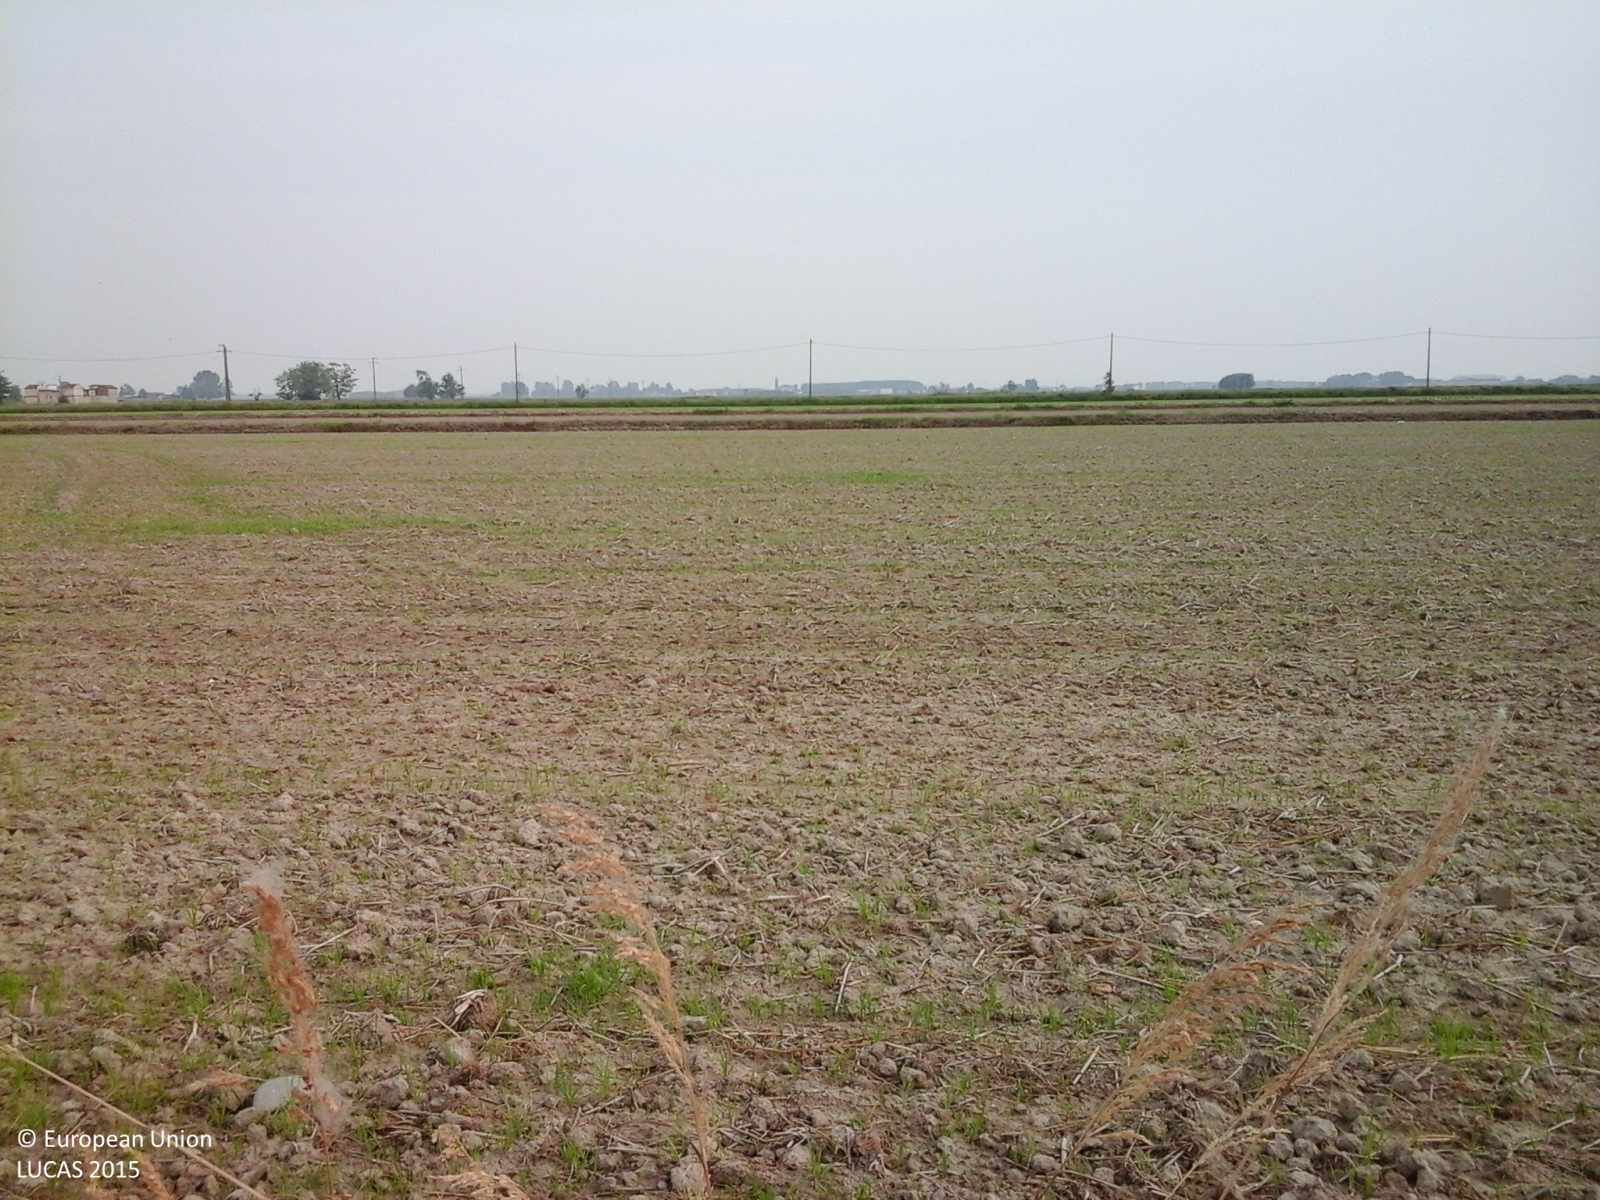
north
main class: Cropland
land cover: Rice
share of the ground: < 10 %
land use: Agriculture (excluding fallow land and kitchen gardens)
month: May
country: IT
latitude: 45.1882
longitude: 8.5644
